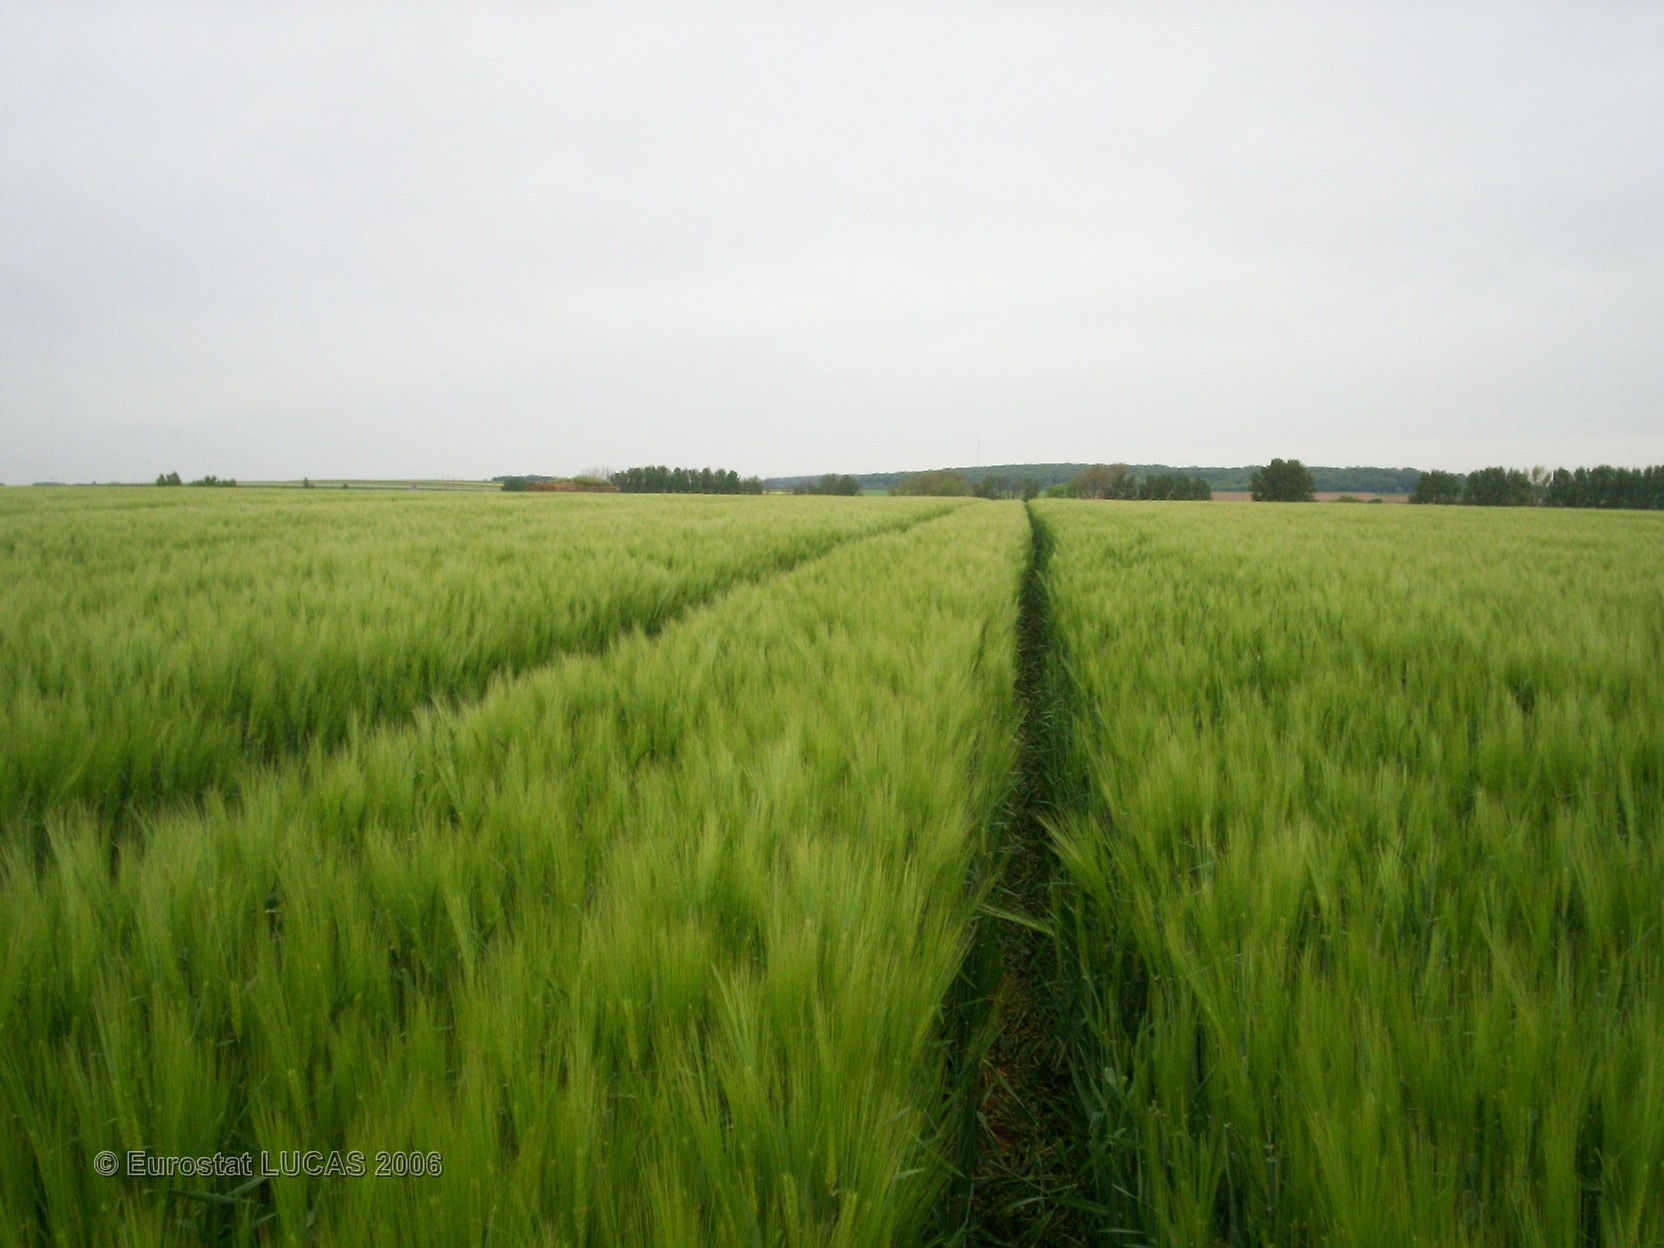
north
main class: Cropland
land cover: Barley
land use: Agriculture (excluding fallow land and kitchen gardens)
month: May
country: FR
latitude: 50.3434
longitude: 2.6391
